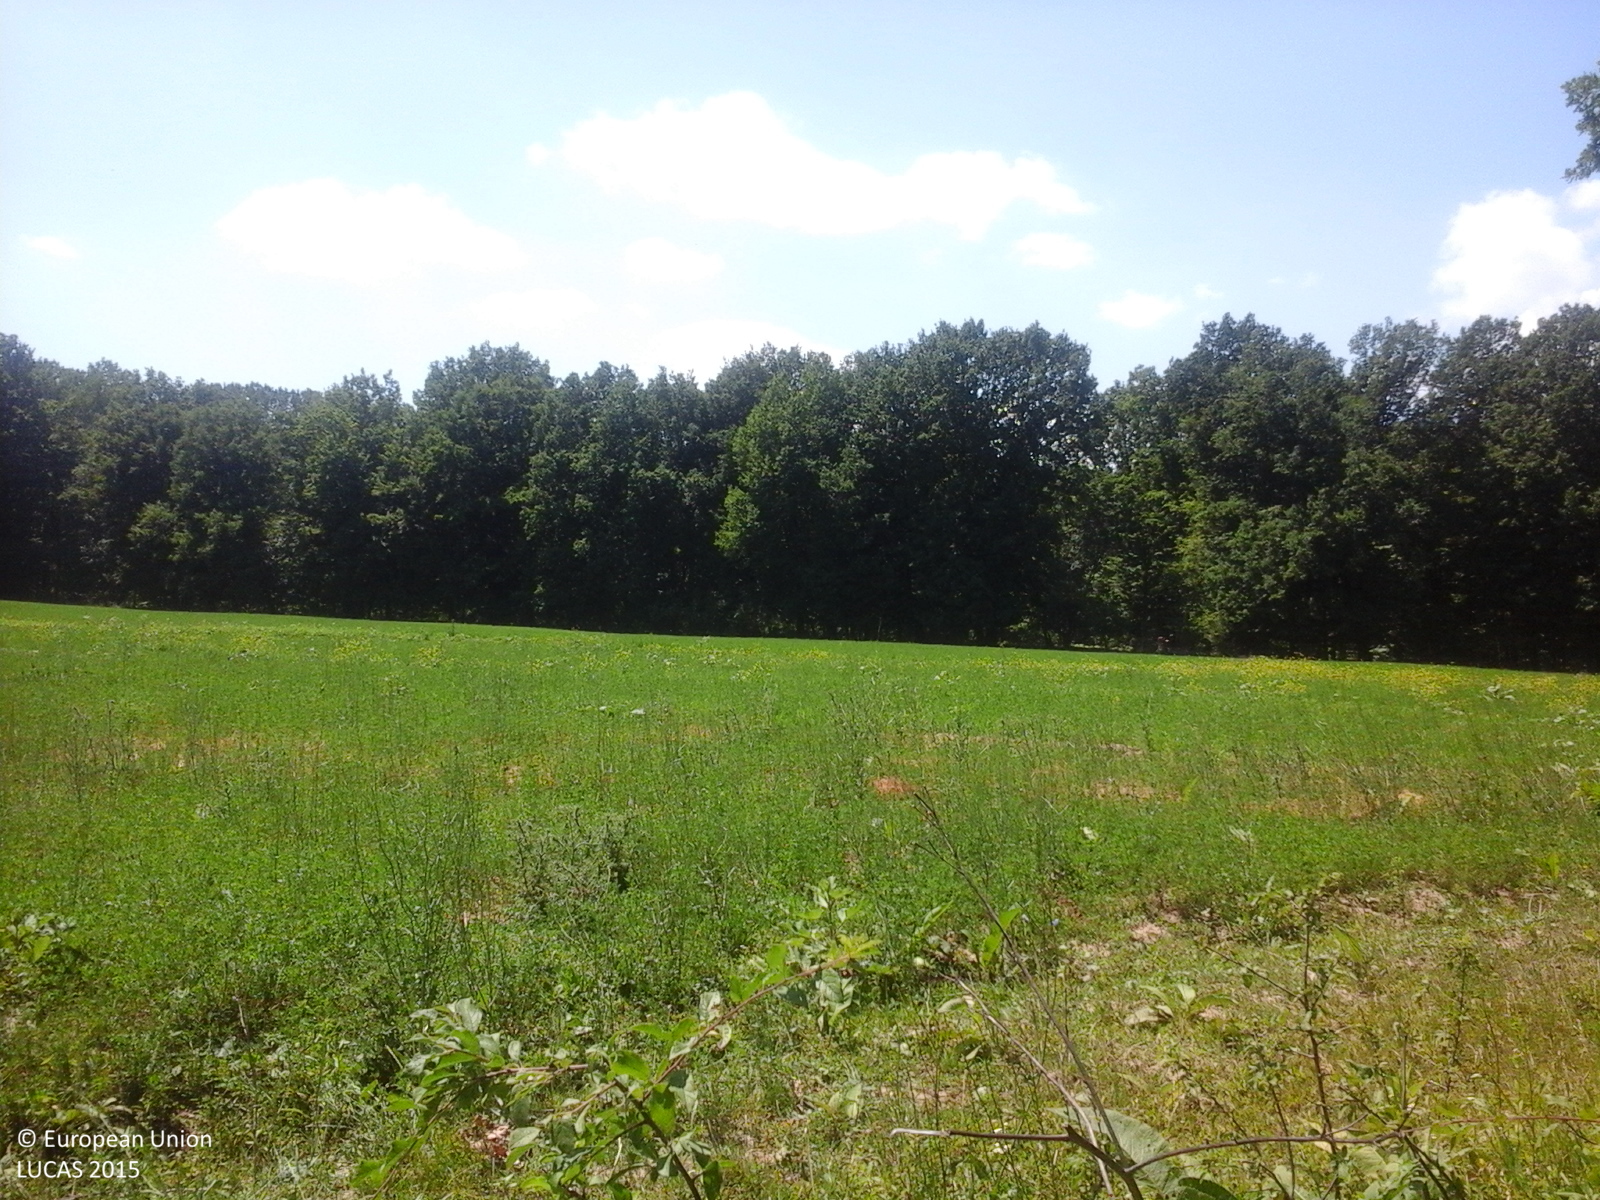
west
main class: Woodland
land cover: Broadleaved woodland
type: mesophytic deciduous forest
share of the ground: > 75 %
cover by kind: broadleaved forest trees 100 %
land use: Forestry
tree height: > 5 m
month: June
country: RO
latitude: 46.9941
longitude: 27.2678
